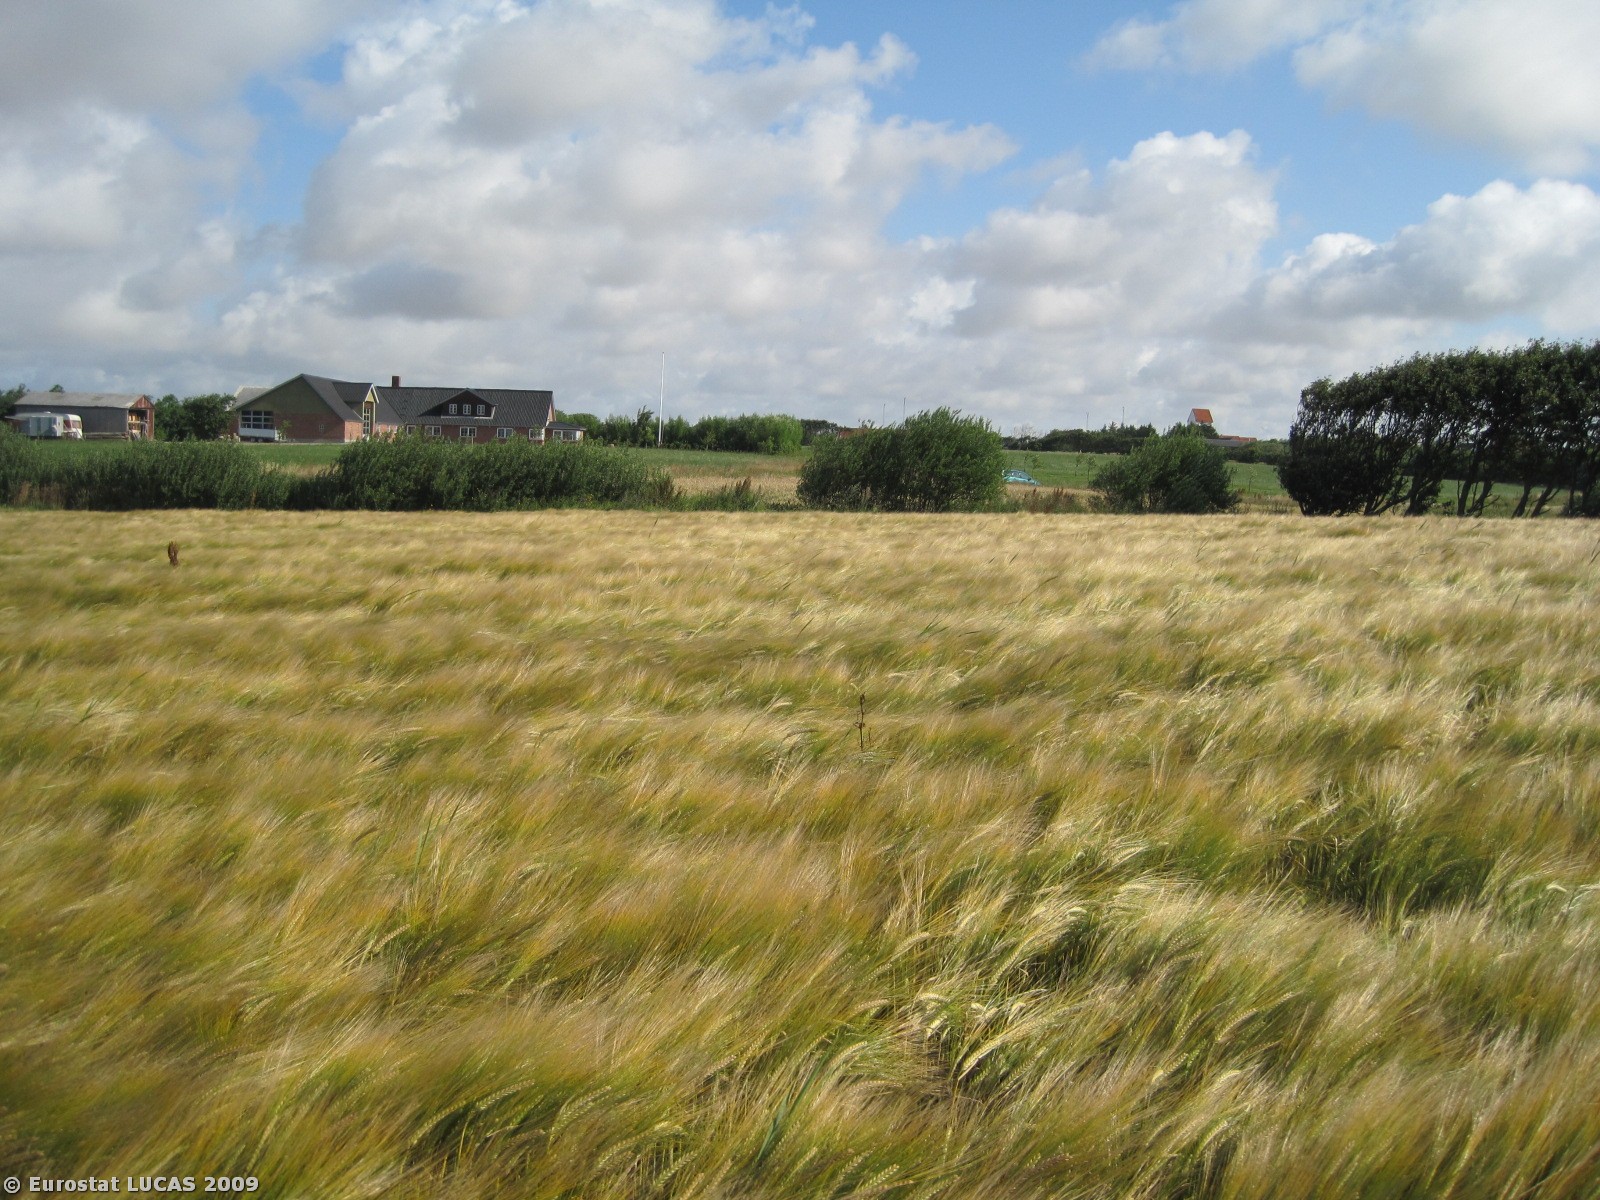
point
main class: Cropland
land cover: Barley
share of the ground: > 75 %
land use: Agriculture (excluding fallow land and kitchen gardens)
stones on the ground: < 10 %
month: July
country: DK
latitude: 56.7166
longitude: 8.3519
